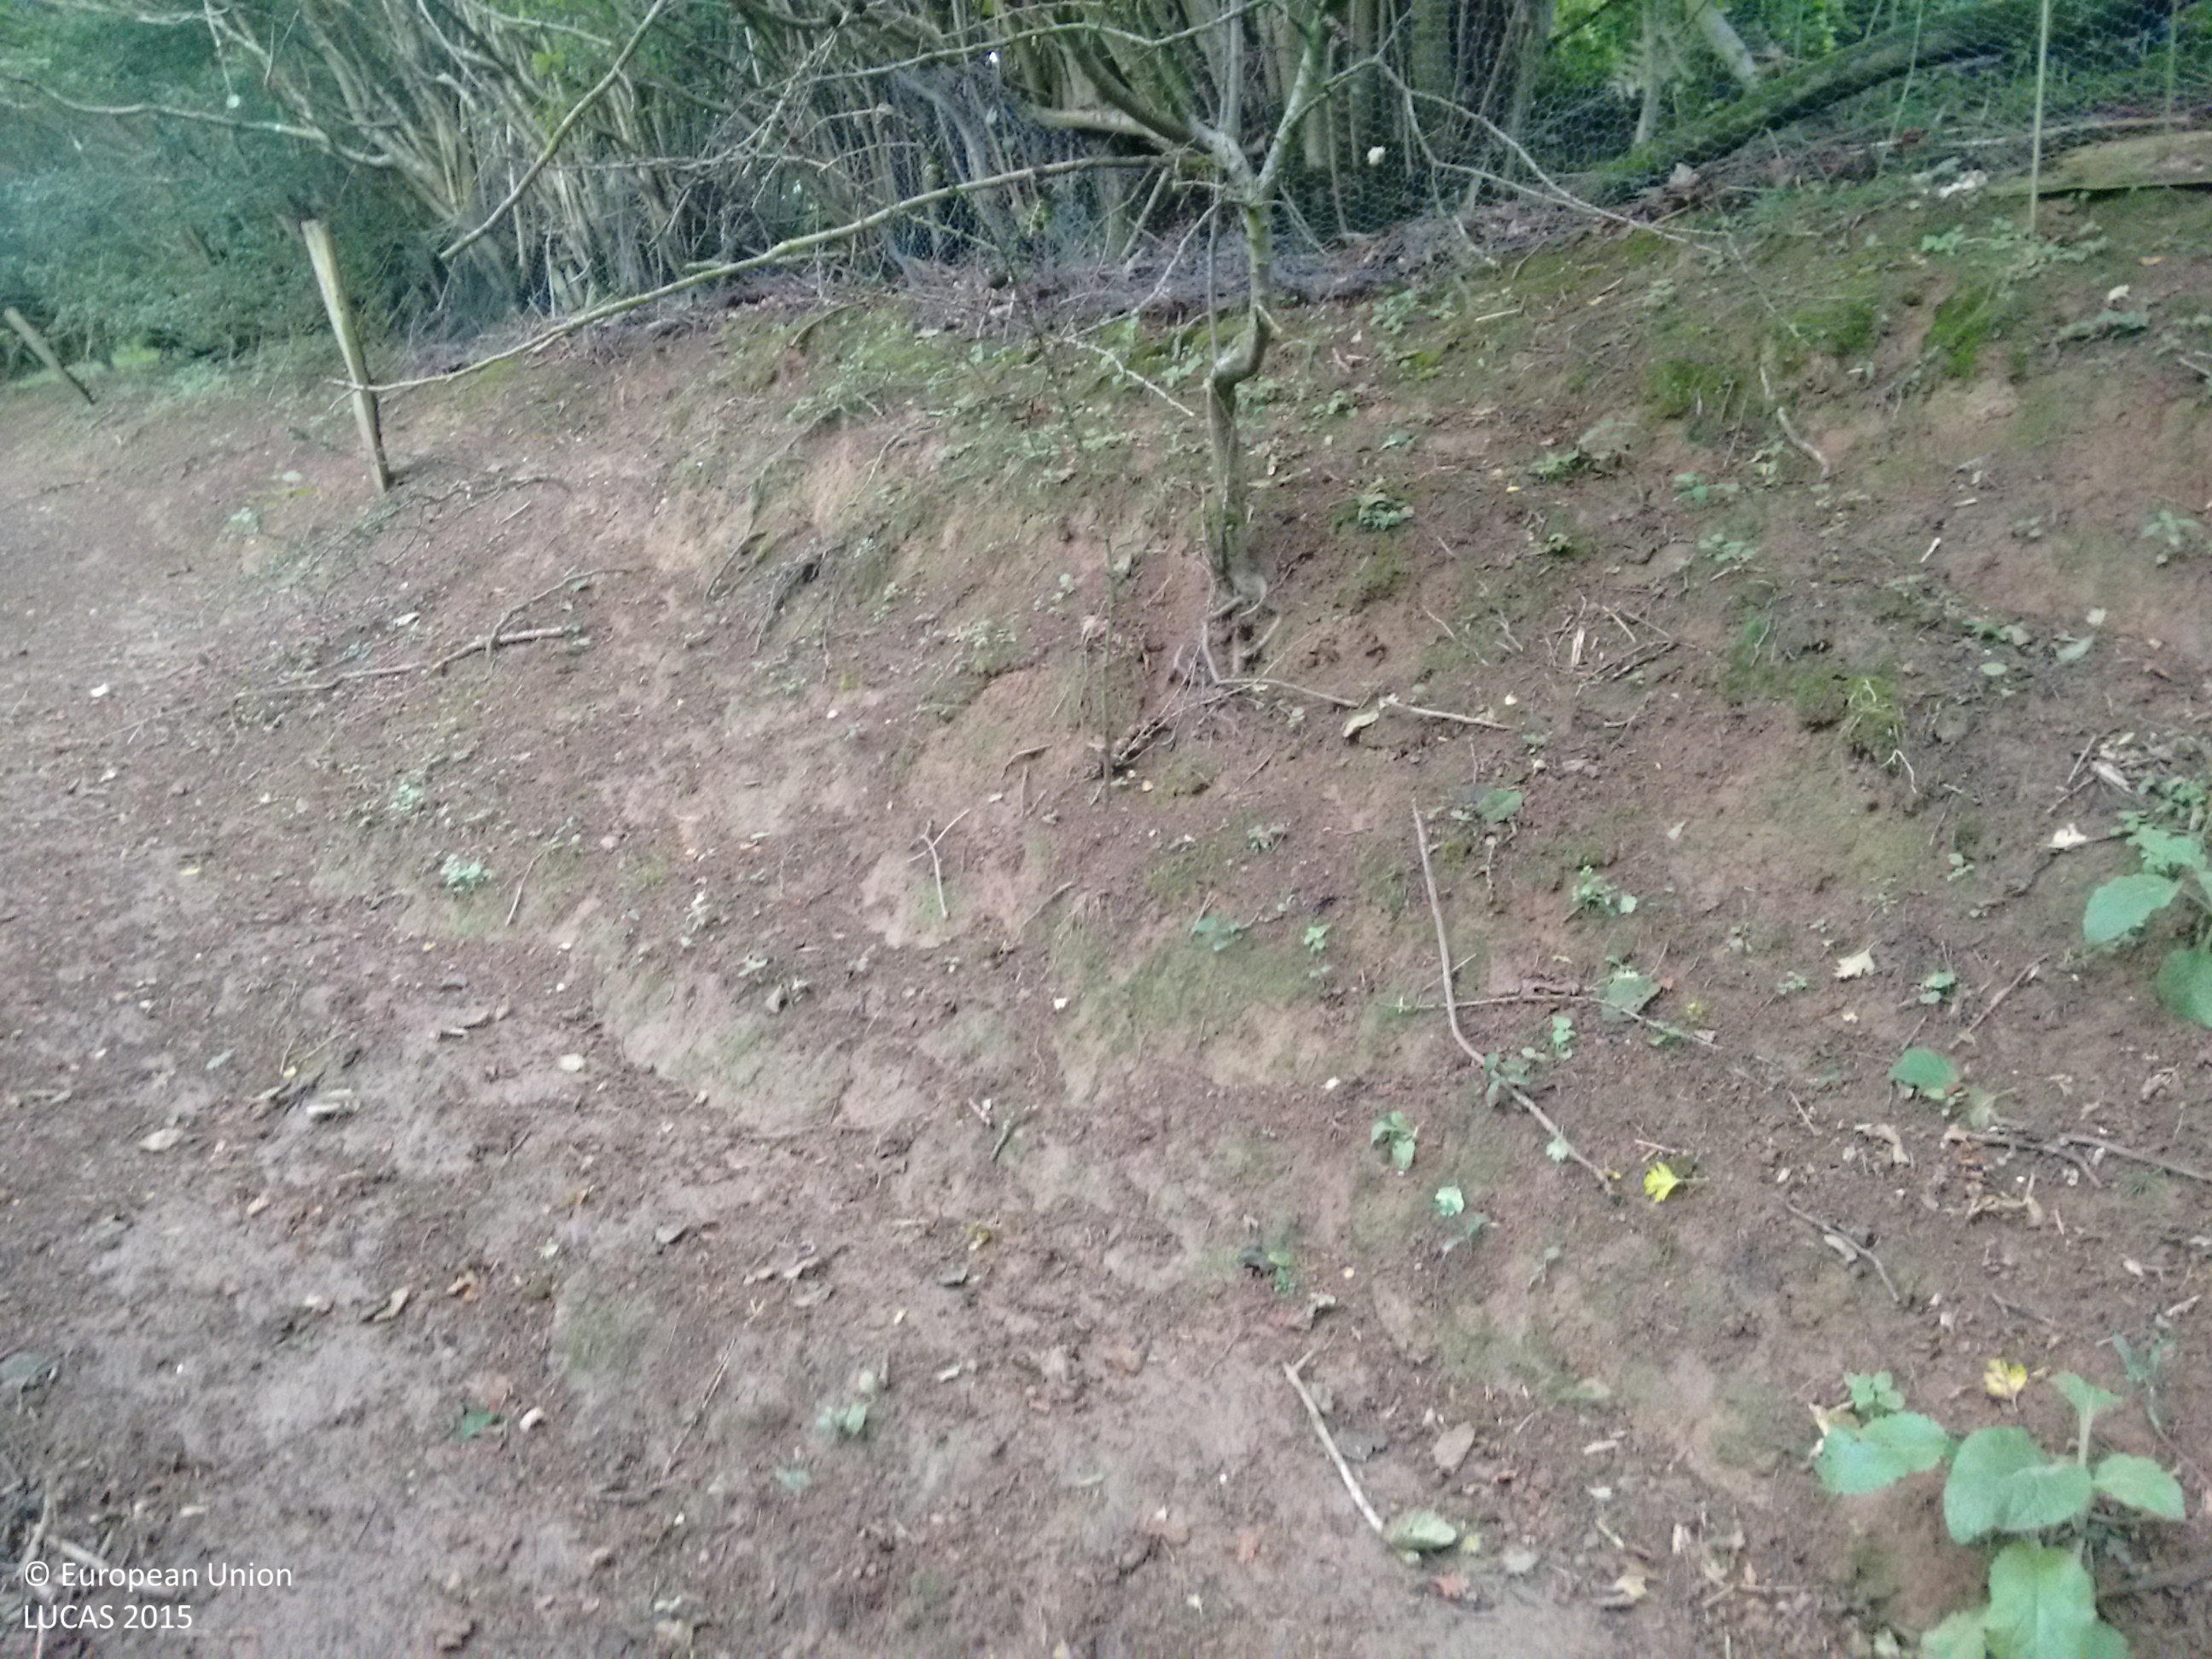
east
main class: Woodland
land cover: Other mixed woodland
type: mesophytic deciduous forest
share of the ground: > 75 %
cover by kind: broadleaved forest trees 55 %, coniferous forest trees 40 %, shrubs 5 %
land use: Semi-natural and natural areas not in use
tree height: > 5 m
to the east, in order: Other mixed woodland; Fences; Other mixed woodland; Tracks; Lines of trees; Fences; Grass margins; Oats; Grass margins; Fences; Grass margins; Dry pulses
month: July
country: GB
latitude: 52.3836
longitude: -2.8694
